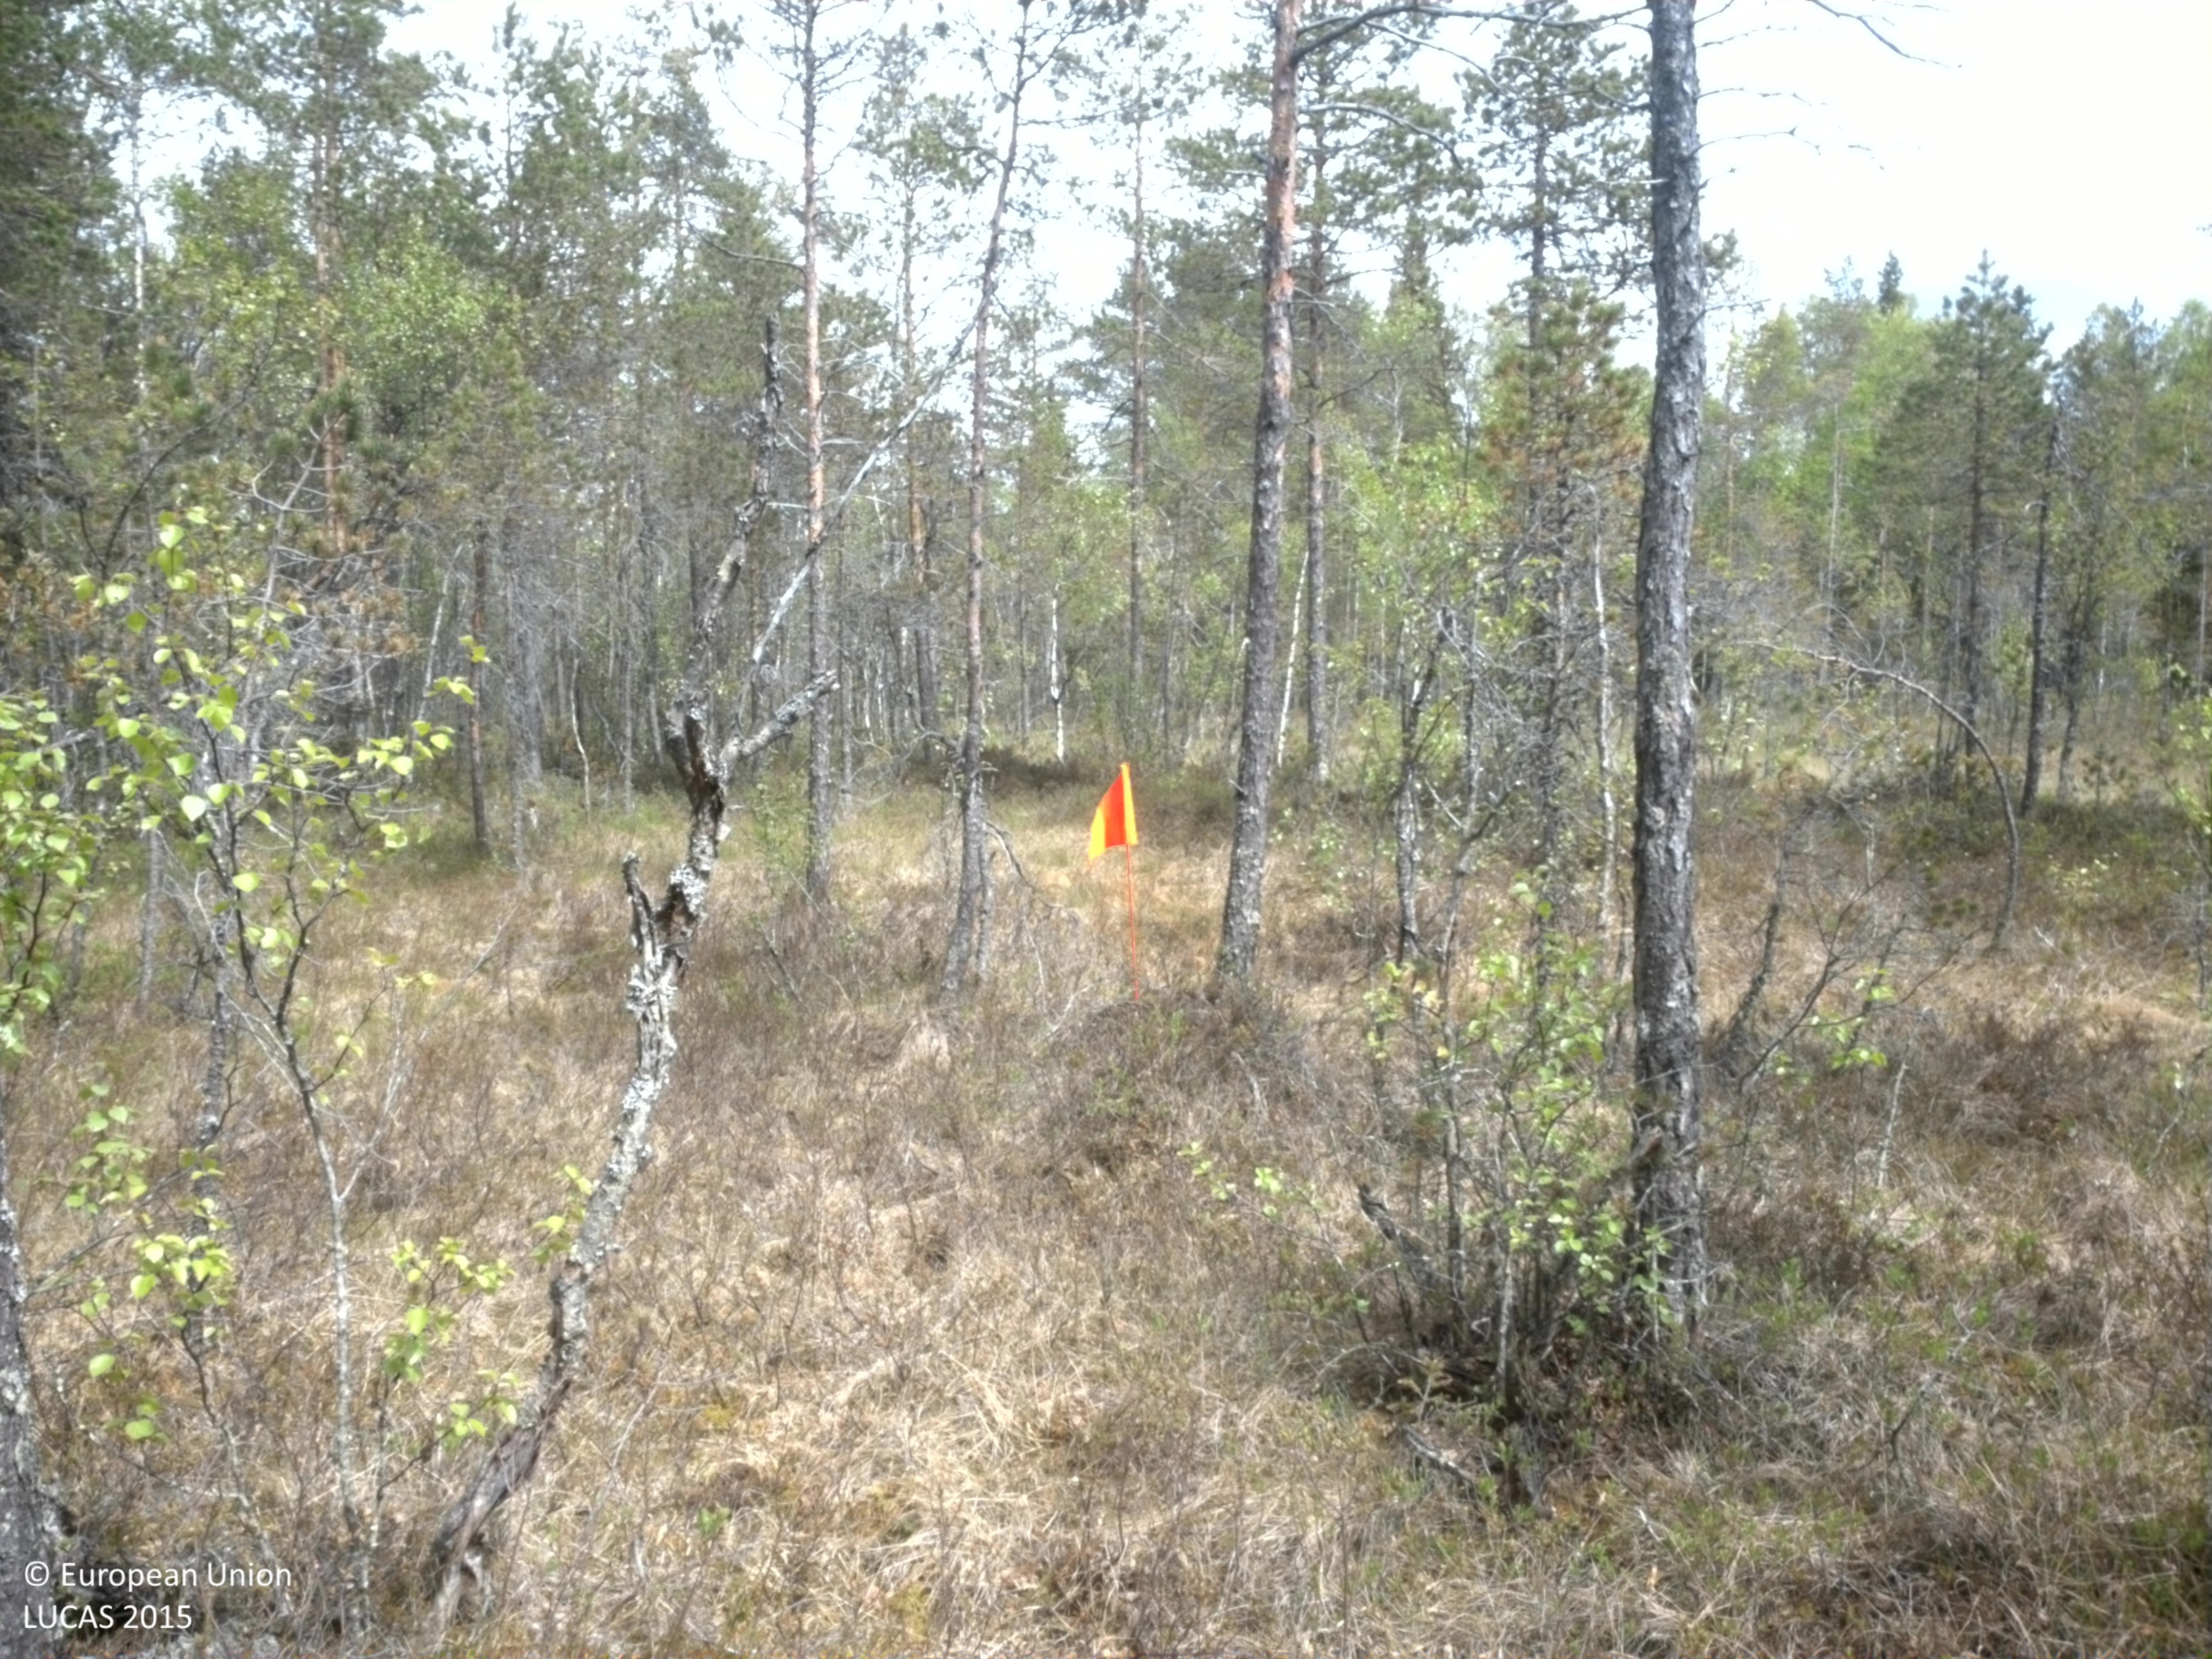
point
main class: Woodland
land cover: Pine dominated coniferous woodland
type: mire and swamp forests
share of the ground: 50 - 75 %
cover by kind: coniferous forest trees 60 %, broadleaved forest trees 15 %, shrubs 15 %, herbaceous plants 10 %
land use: Semi-natural and natural areas not in use
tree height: > 5 m
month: June
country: SE
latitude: 63.8460
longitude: 20.5370
